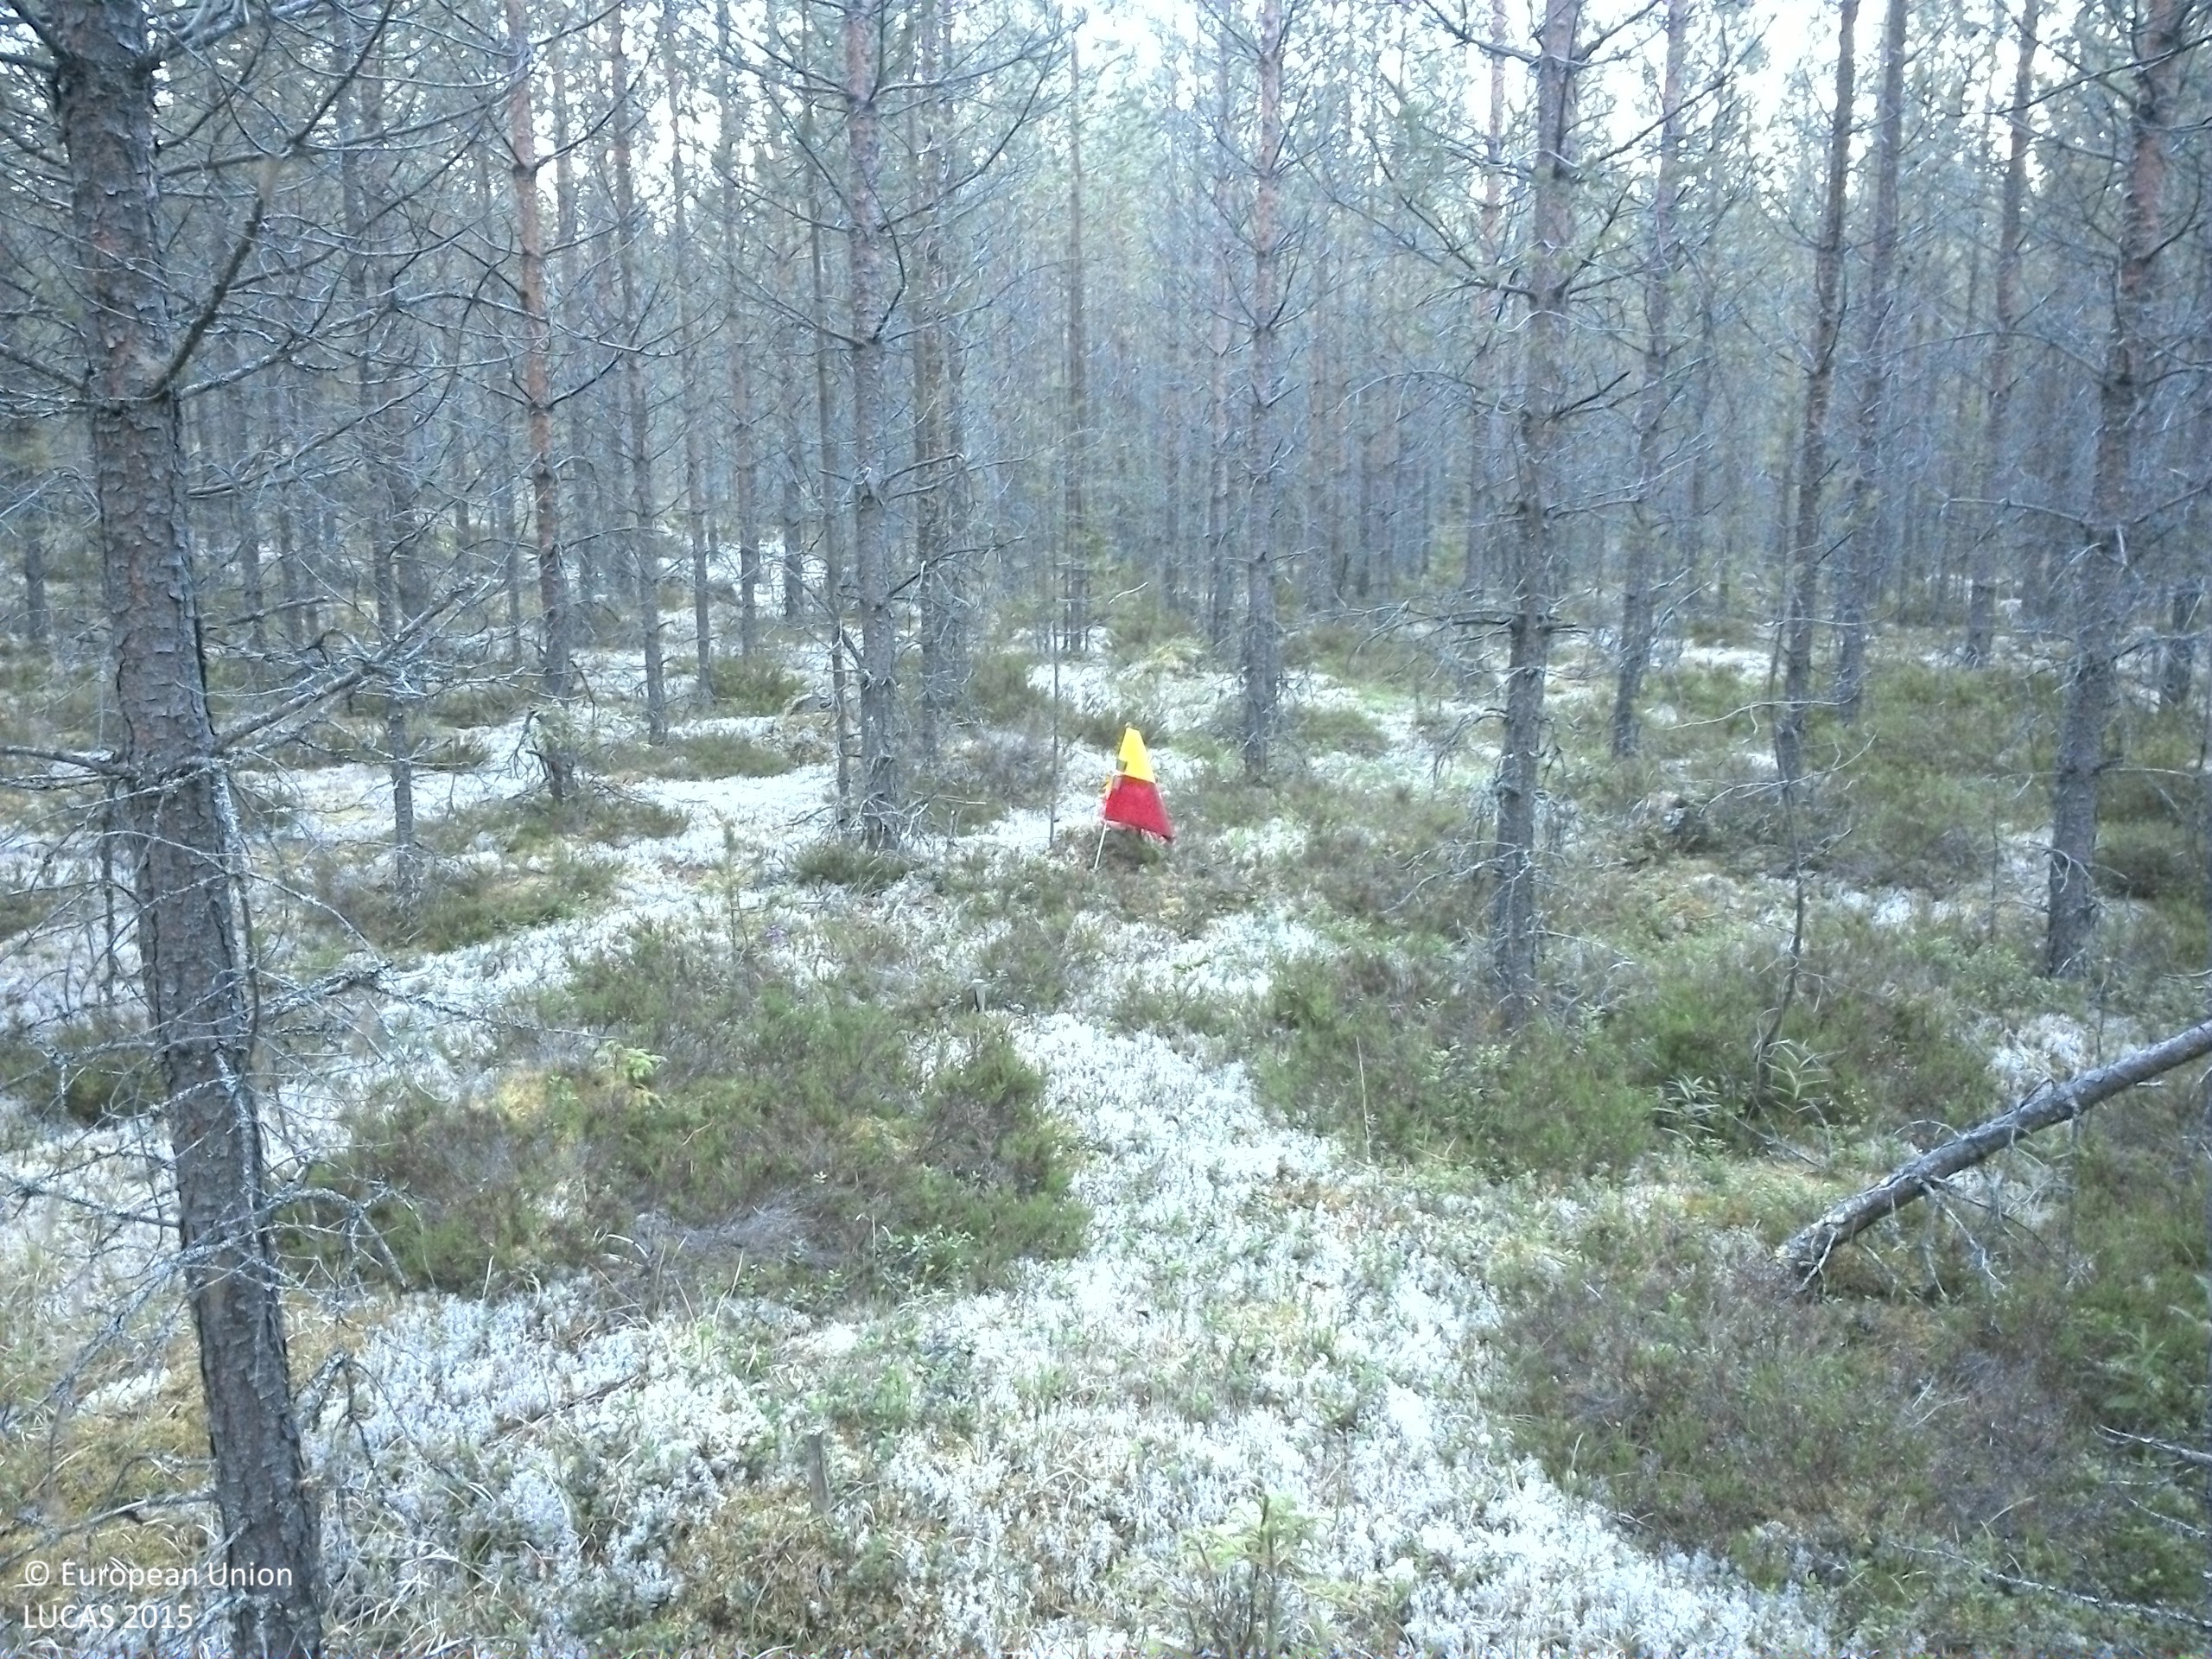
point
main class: Woodland
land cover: Pine dominated coniferous woodland
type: boreal forest
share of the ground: 25 - 50 %
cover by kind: lichens and mosses 45 %, coniferous forest trees 35 %, shrubs 20 %
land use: Forestry
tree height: > 5 m
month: August
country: SE
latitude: 63.6720
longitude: 16.3793
